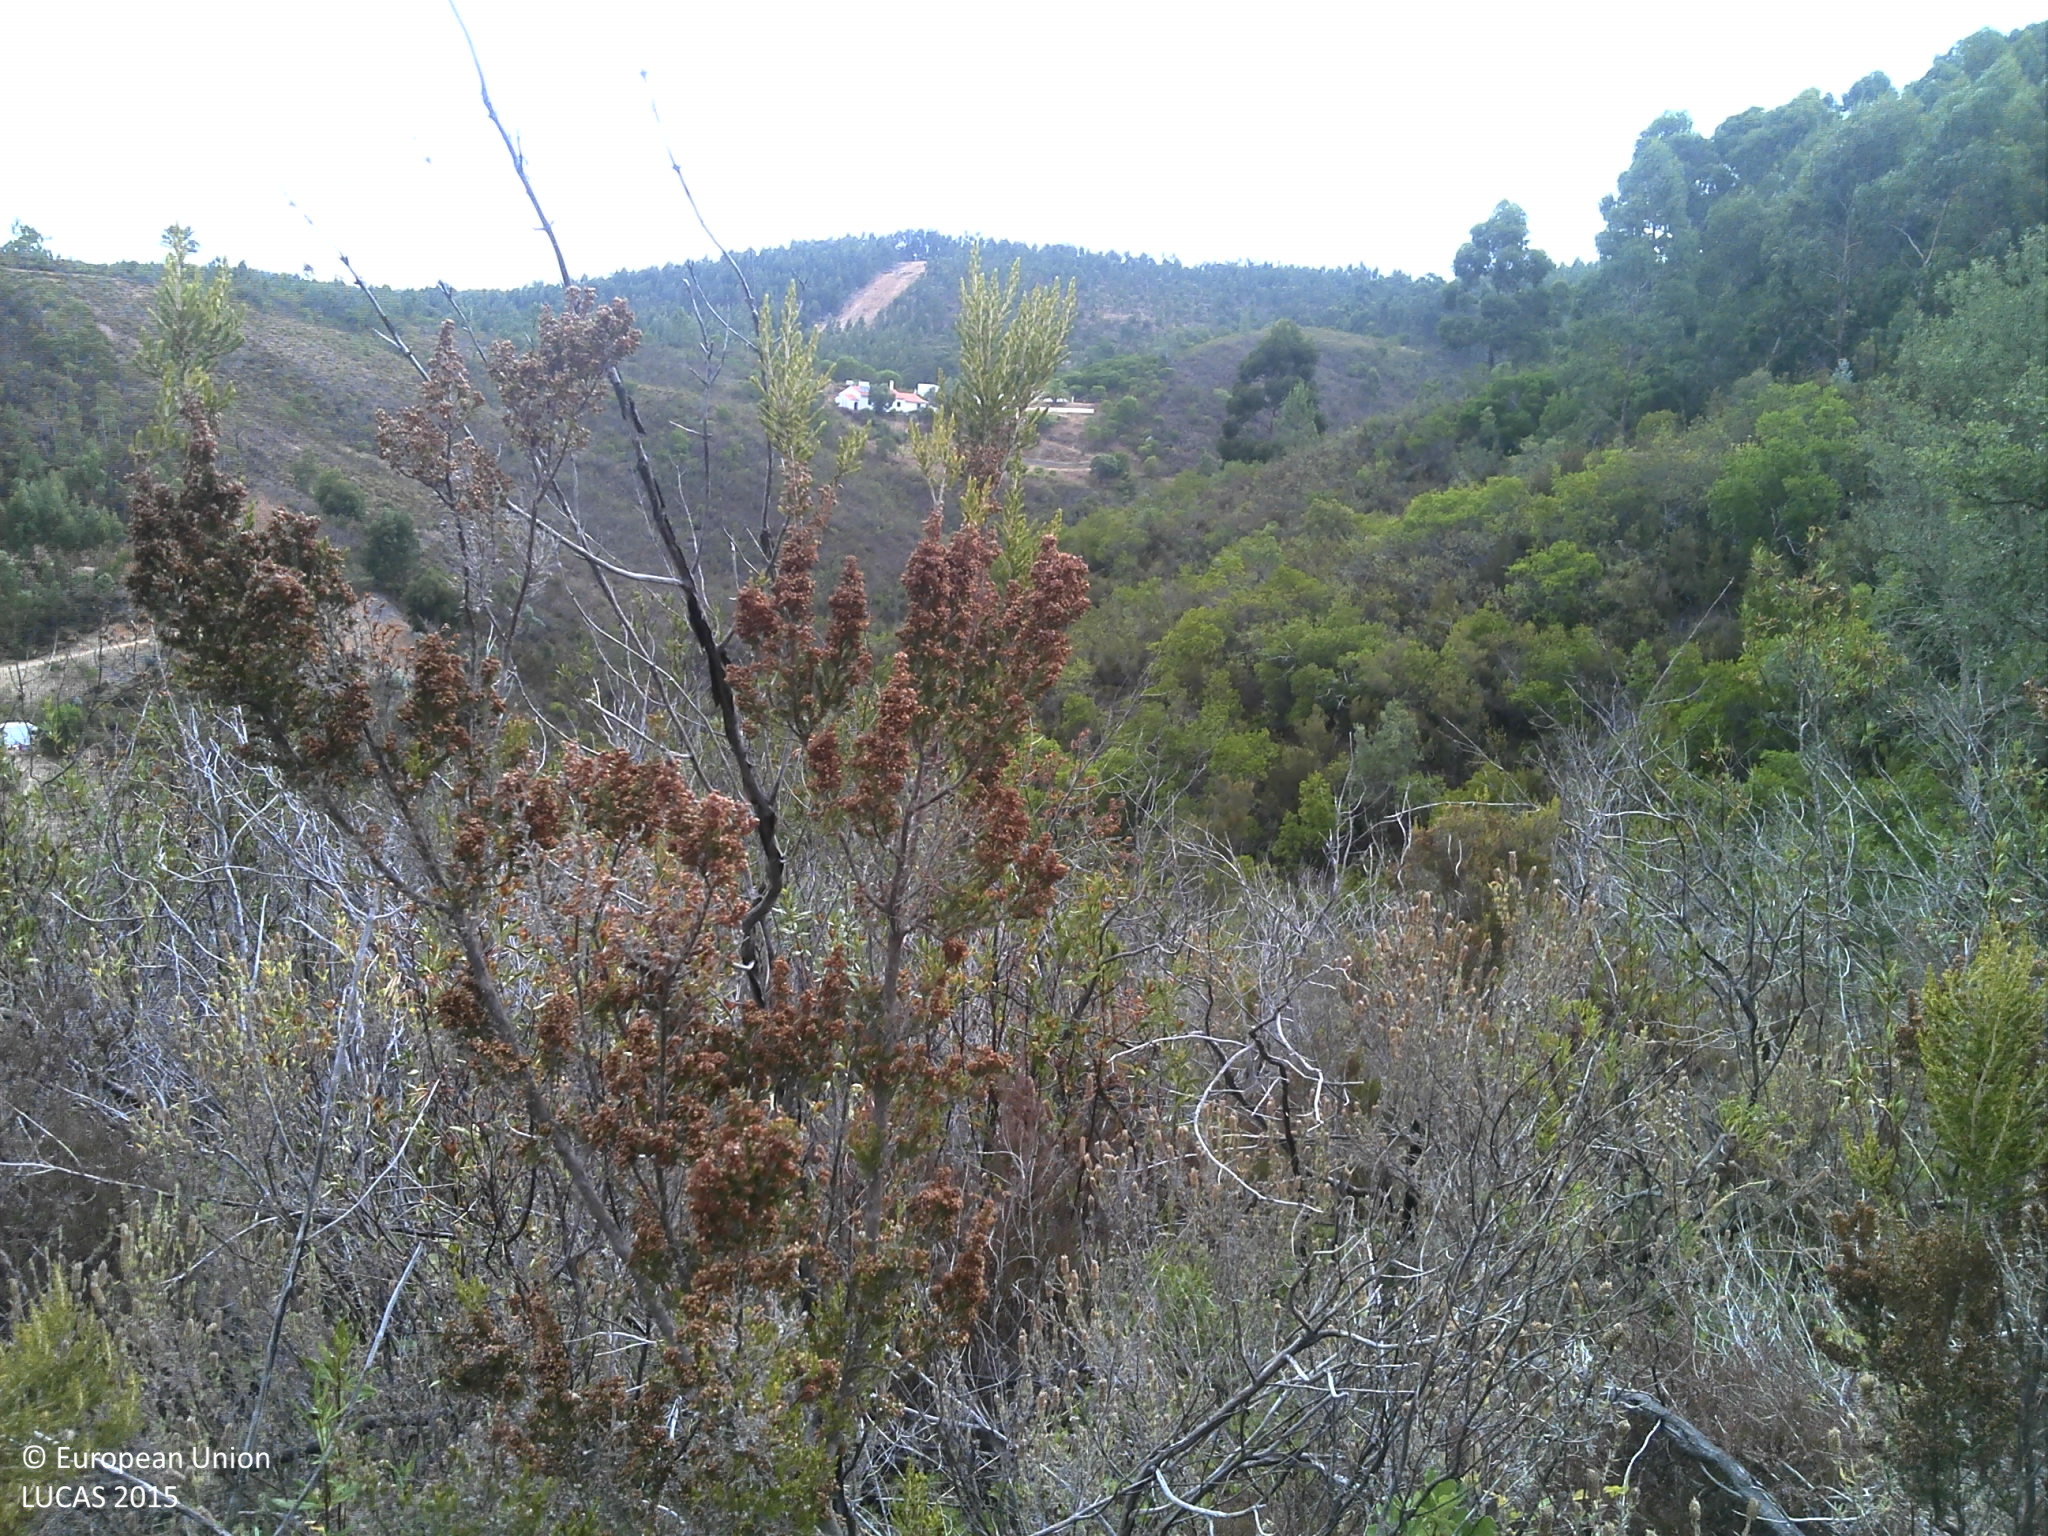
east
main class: Shrubland
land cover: Shrubland with sparse tree cover
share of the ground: > 75 %
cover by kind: shrubs 75 %, herbaceous plants 15 %, broadleaved forest trees 5 %, unconsolidated bare surface 5 %
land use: Abandoned areas
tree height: < 5 m
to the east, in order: Shrubland with sparse tree cover
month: July
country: PT
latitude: 37.3499
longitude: -8.7411
